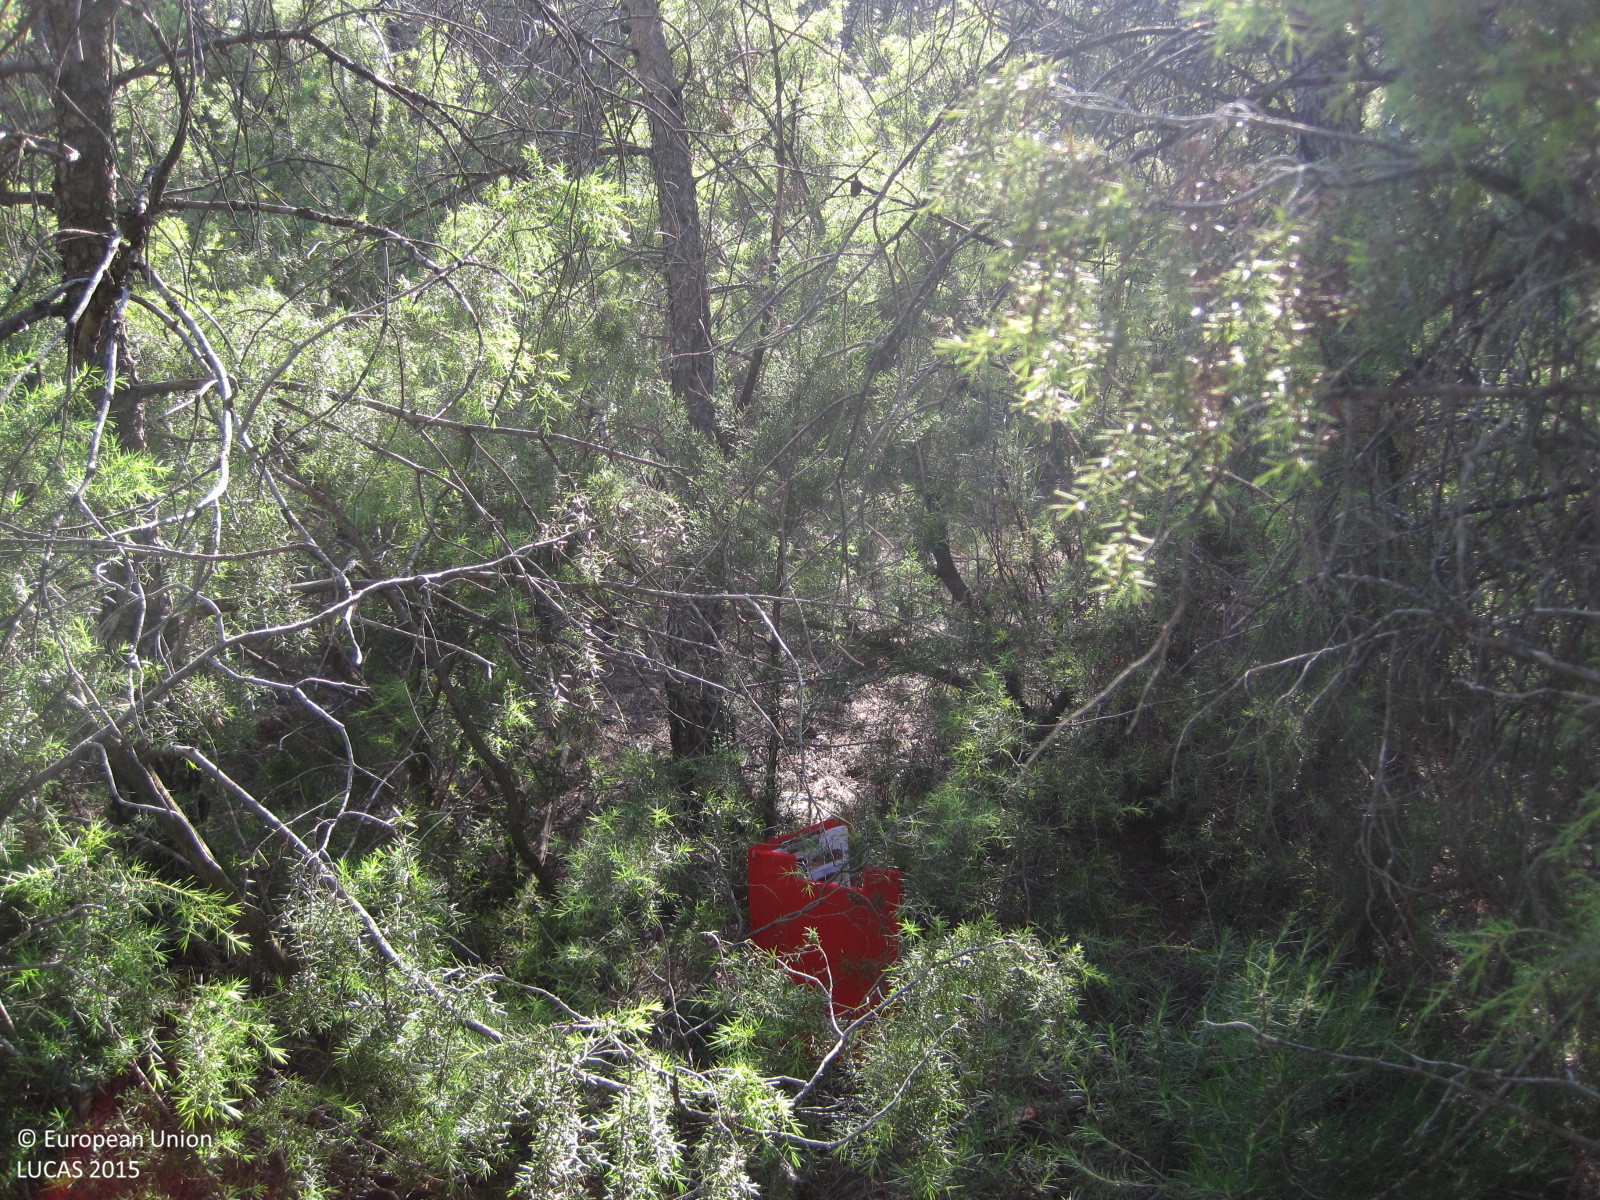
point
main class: Woodland
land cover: Pine dominated coniferous woodland
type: coniferous forest of the mediterranean region
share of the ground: > 75 %
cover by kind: coniferous forest trees 90 %, shrubs 10 %
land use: Forestry
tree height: > 5 m
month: May
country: ES
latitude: 39.6115
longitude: -1.1497
